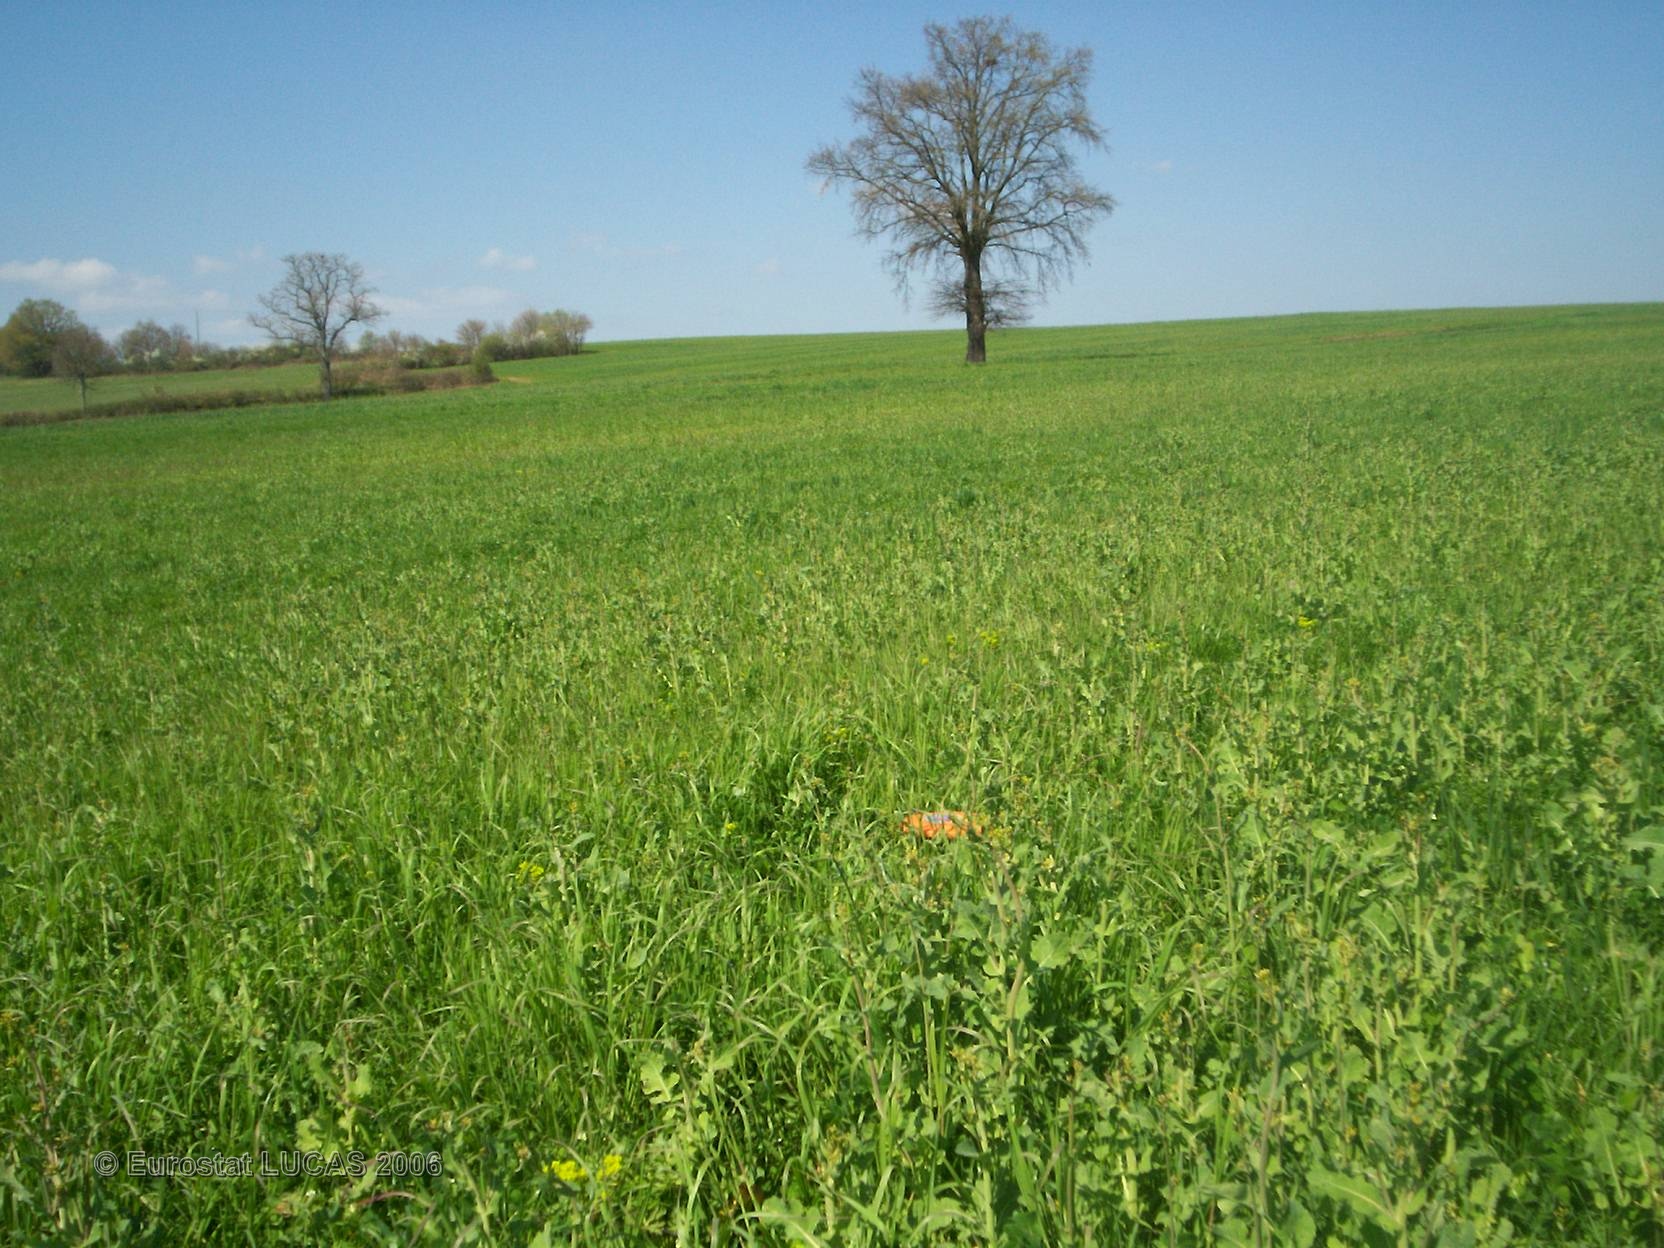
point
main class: Grassland
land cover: Grassland without tree/shrub cover
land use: Agriculture (excluding fallow land and kitchen gardens)
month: April
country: FR
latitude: 46.6318
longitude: 3.0611
